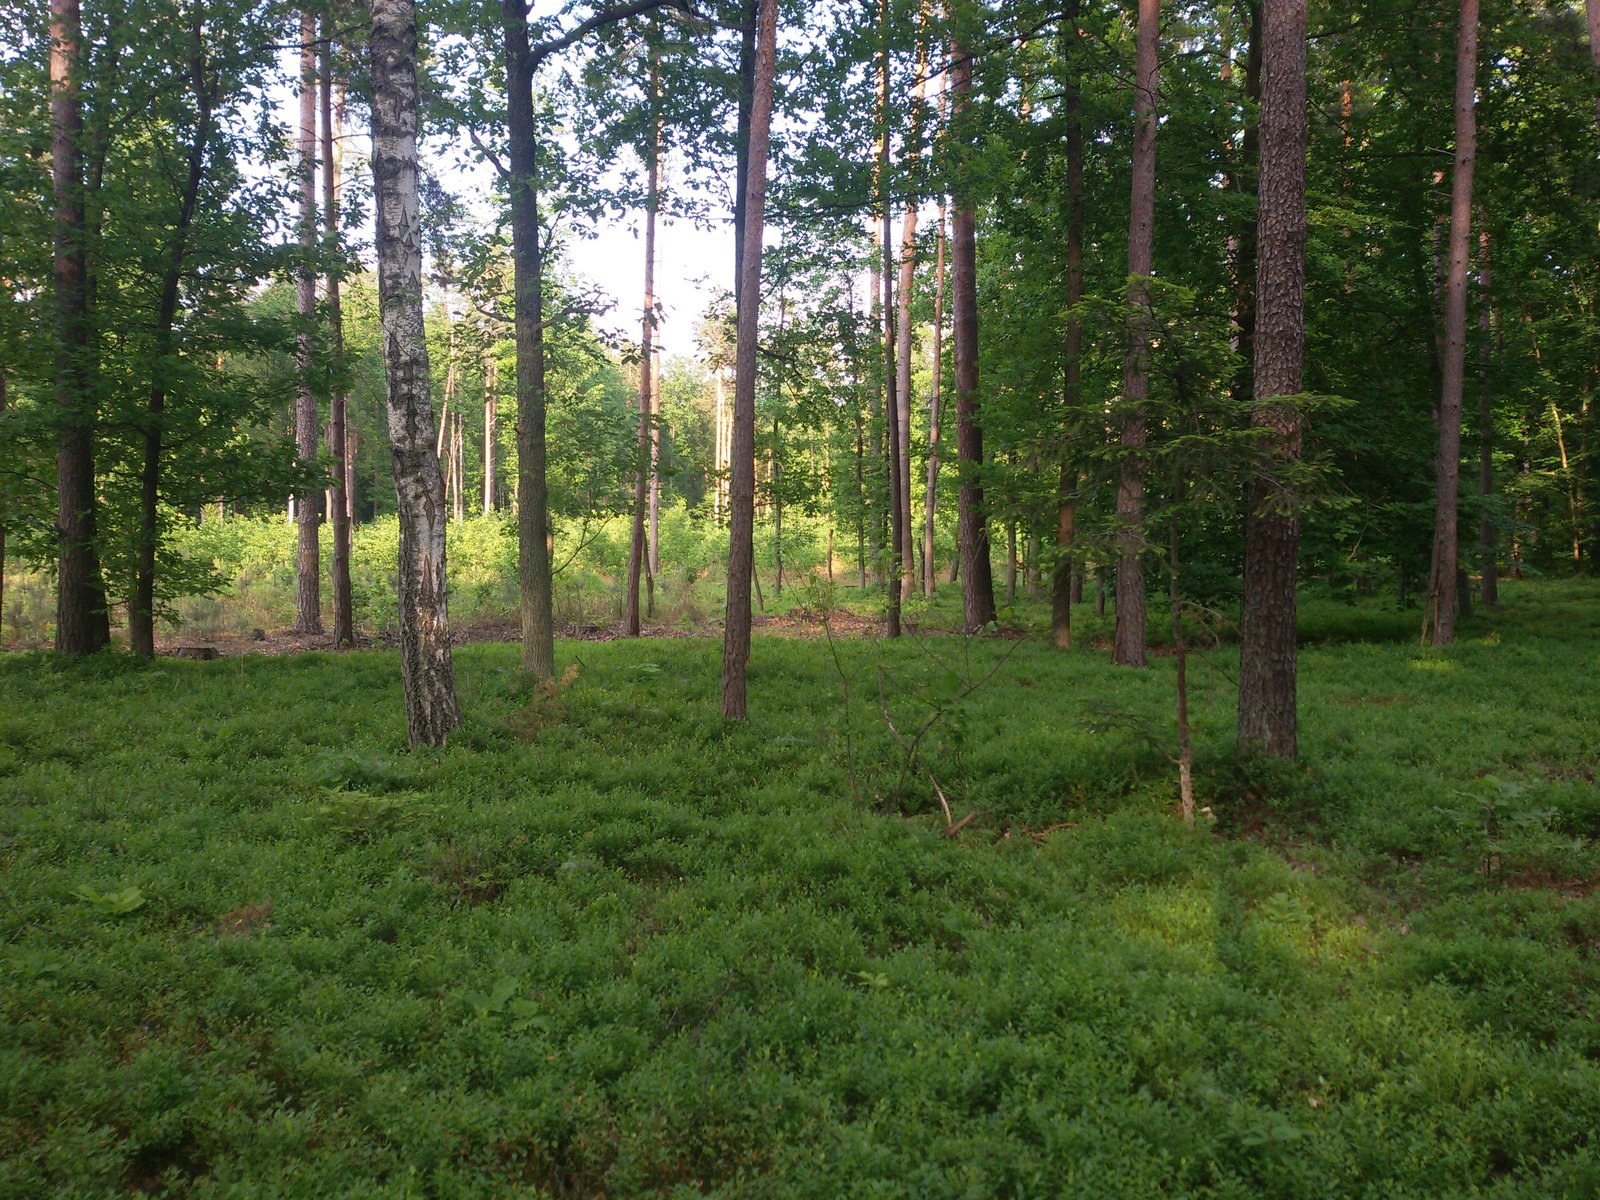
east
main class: Woodland
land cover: Pine dominated coniferous woodland
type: hemiboreal forest and nemoral coniferous forest and mixed broadleaved-coniferous forest
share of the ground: 25 - 50 %
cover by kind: coniferous forest trees 45 %, shrubs 30 %, herbaceous plants 20 %, lichens and mosses 5 %
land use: Forestry
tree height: > 5 m
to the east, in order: Pine dominated coniferous woodland; Fences; Broadleaved woodland; Fences; Pine dominated mixed woodland; Nurseries
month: June
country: PL
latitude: 50.1859
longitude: 21.6347
